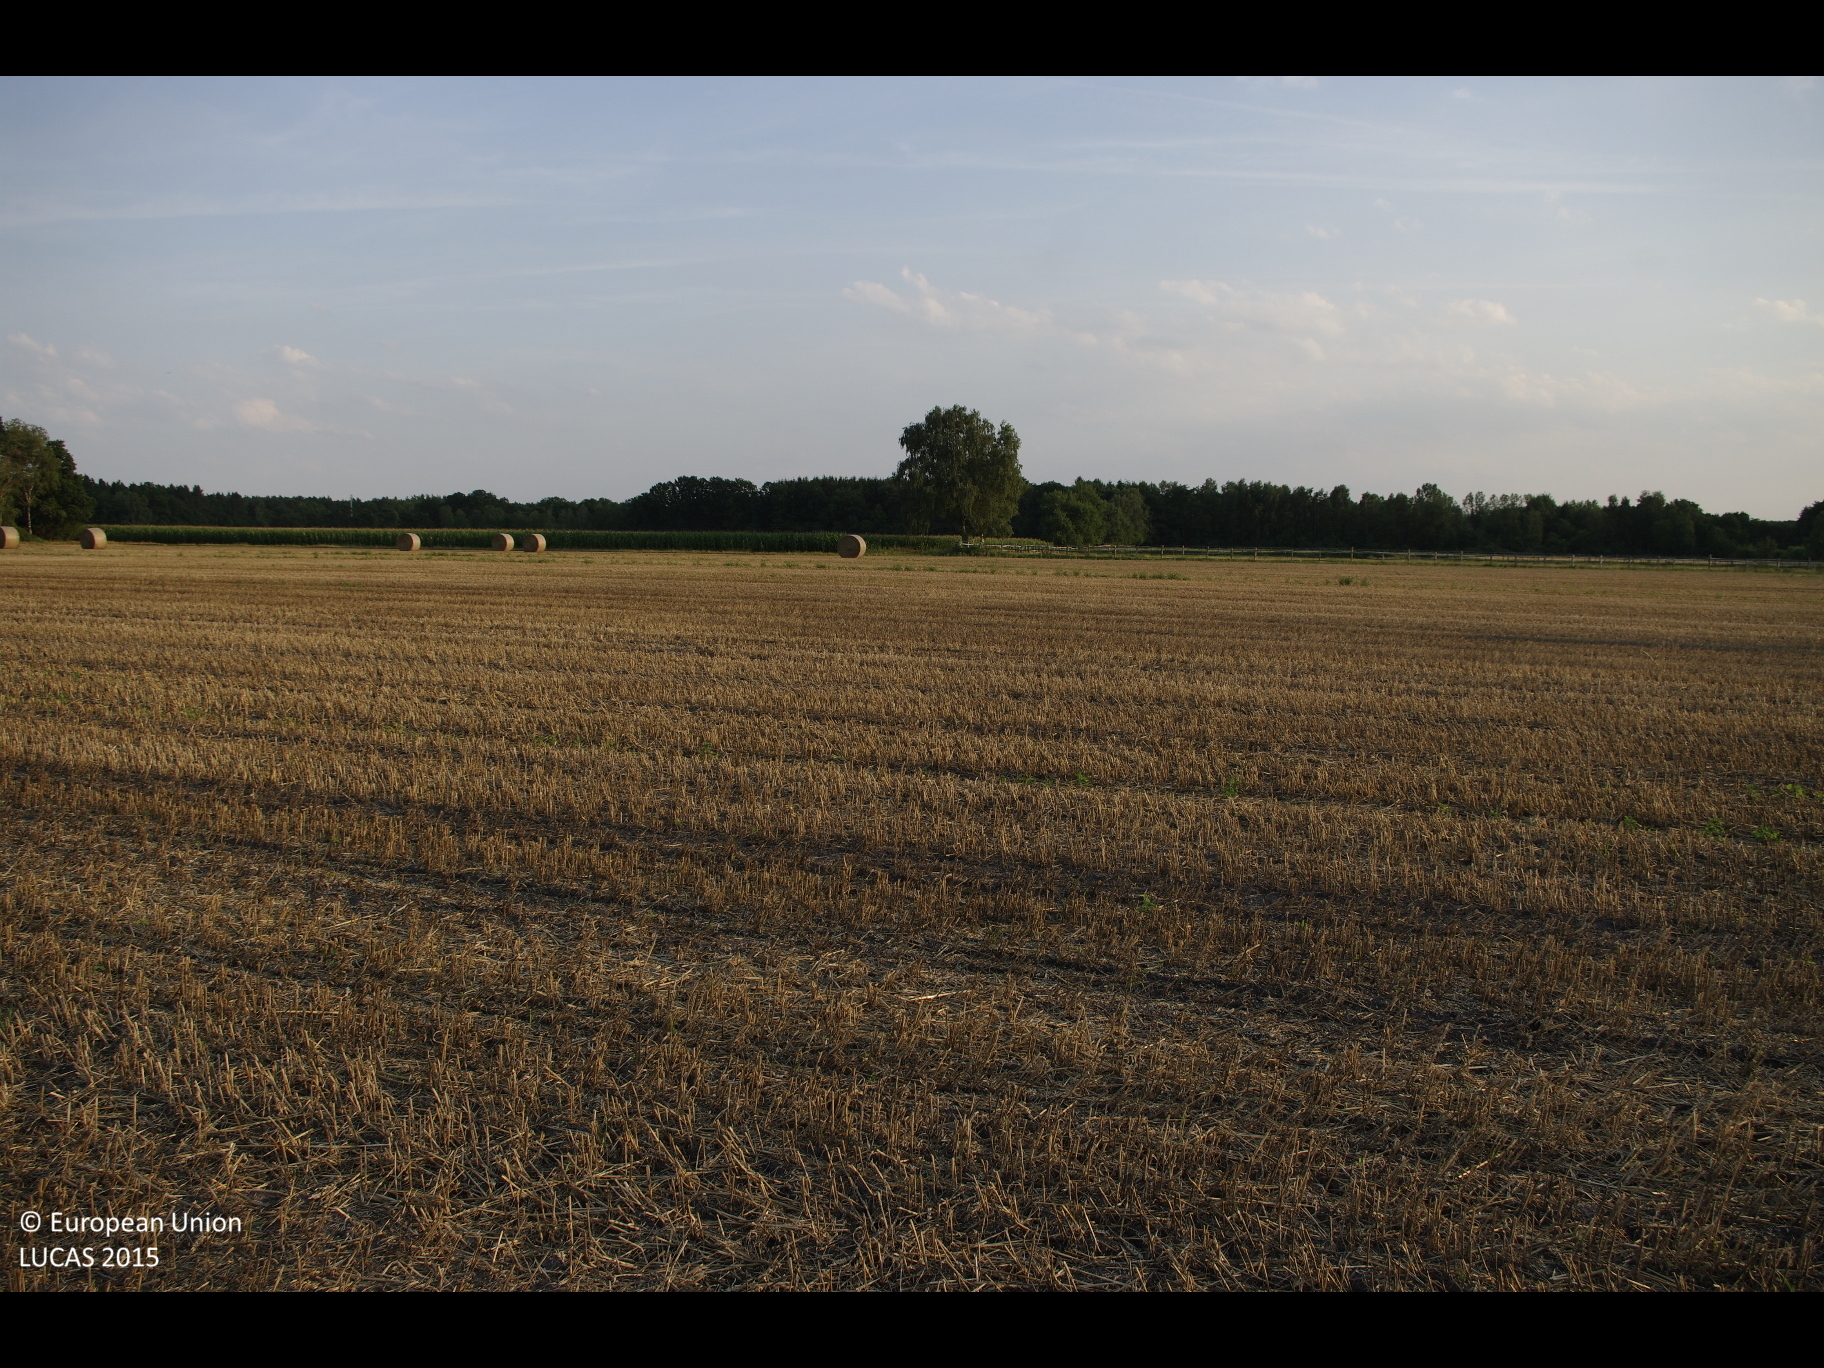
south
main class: Cropland
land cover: Rye
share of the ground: 50 - 75 %
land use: Agriculture (excluding fallow land and kitchen gardens)
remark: Harvested field
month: August
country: DE
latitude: 53.1682
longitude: 9.8355
